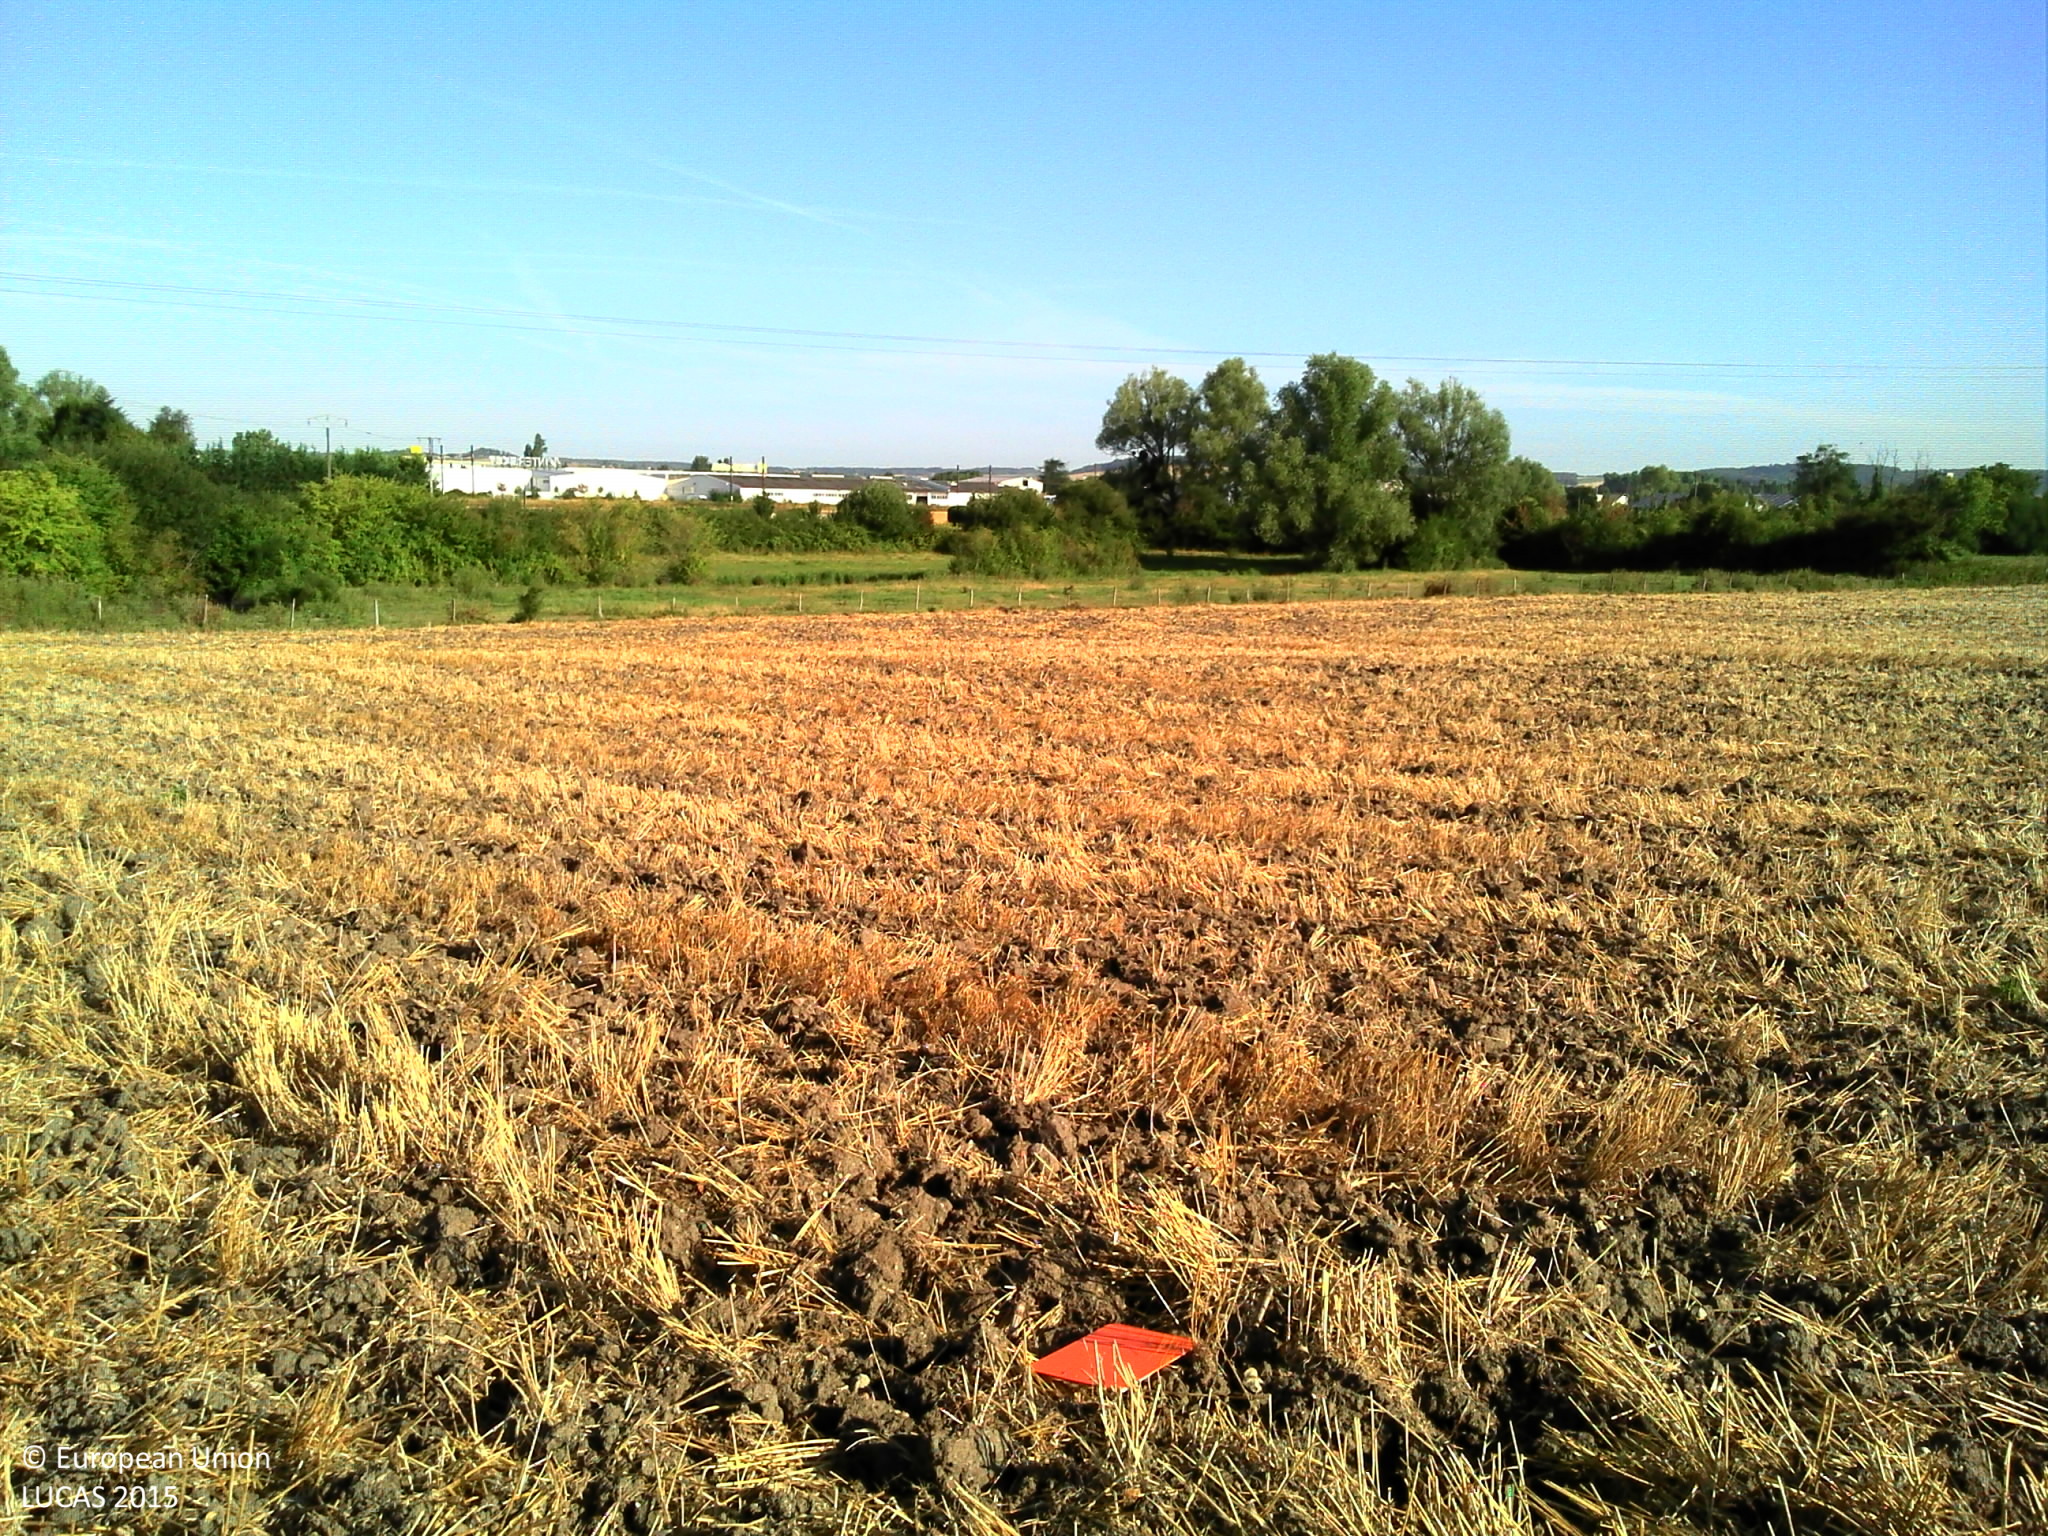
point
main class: Cropland
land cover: Common wheat
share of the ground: 25 - 50 %
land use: Agriculture (excluding fallow land and kitchen gardens)
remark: Tilled/Sowed
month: August
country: FR
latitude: 46.8387
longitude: 0.5542
